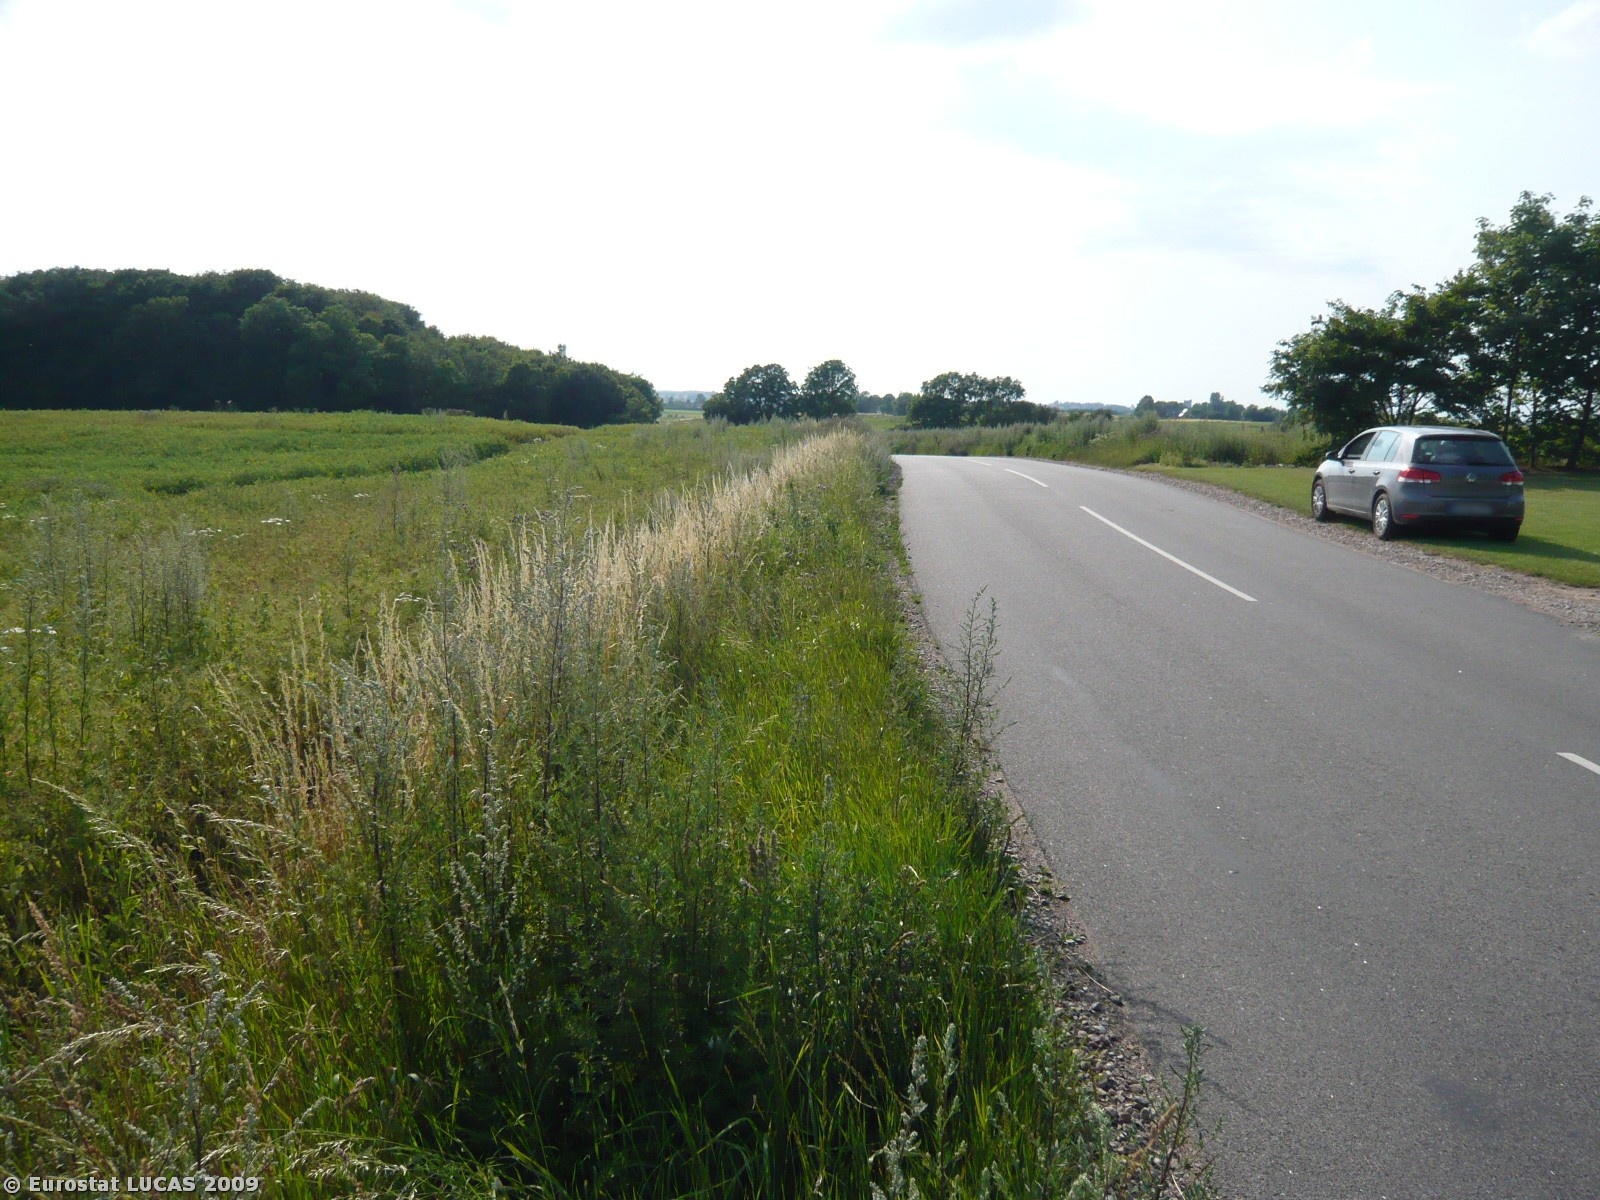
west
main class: Cropland
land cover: Dry pulses
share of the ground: > 75 %
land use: Agriculture (excluding fallow land and kitchen gardens)
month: July
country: DK
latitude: 55.8356
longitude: 11.6430
